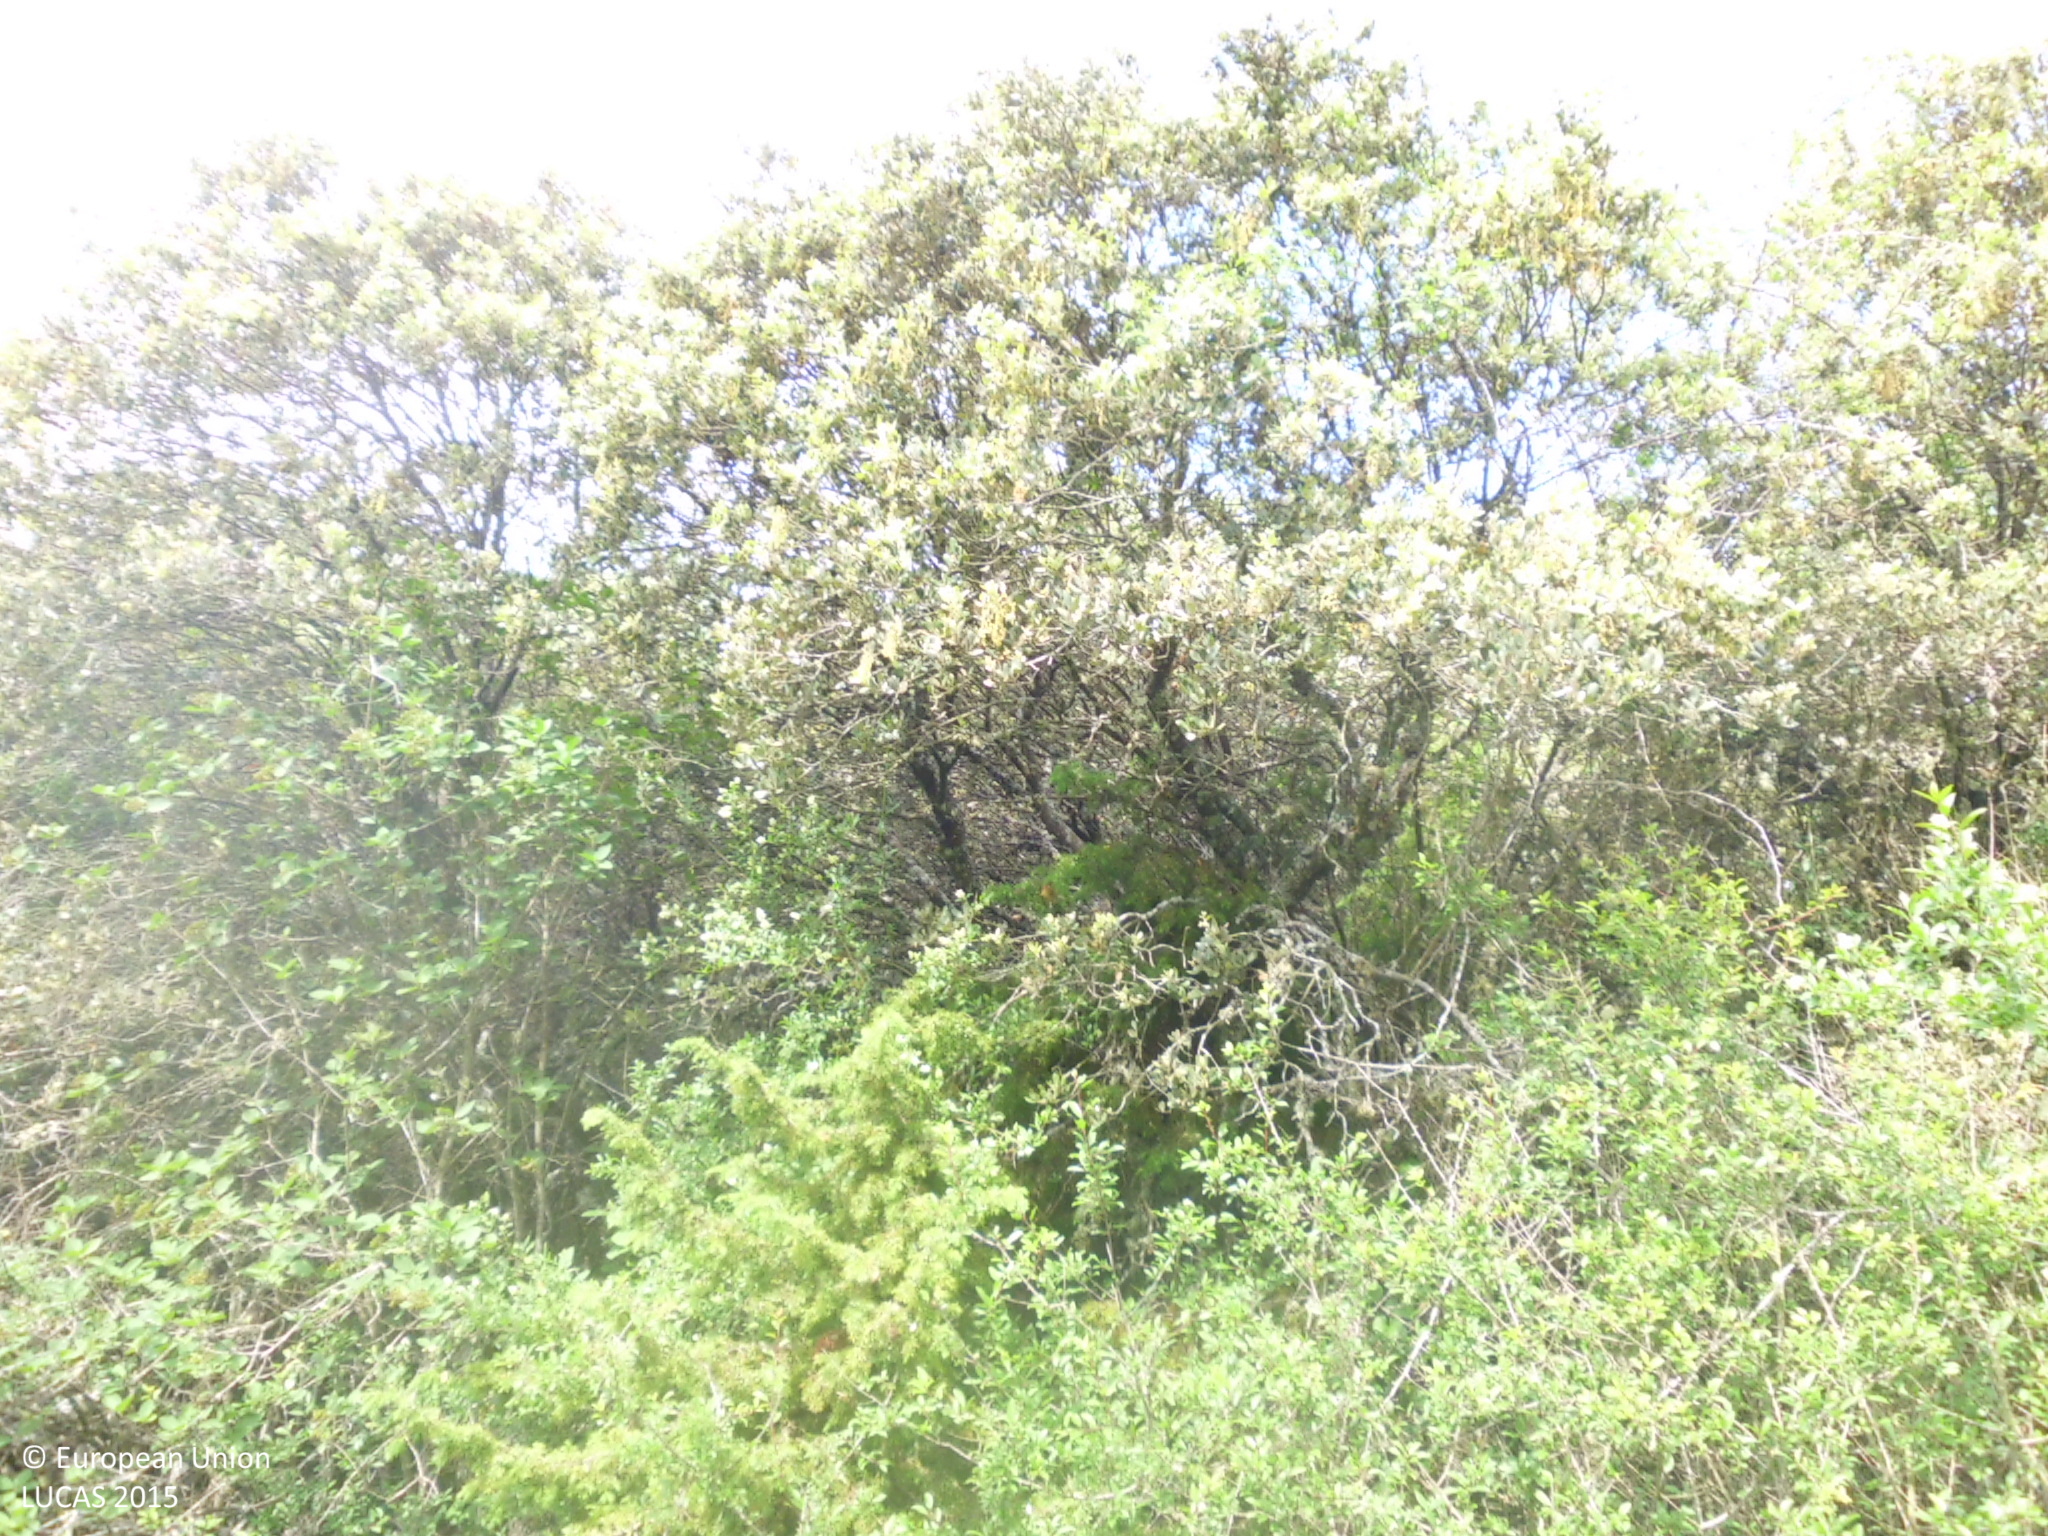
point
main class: Woodland
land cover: Broadleaved woodland
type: broadleaved evergreen forest
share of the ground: 50 - 75 %
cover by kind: broadleaved forest trees 50 %, shrubs 30 %, herbaceous plants 20 %
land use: Semi-natural and natural areas not in use
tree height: > 5 m
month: June
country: ES
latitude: 42.5075
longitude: -3.4084
